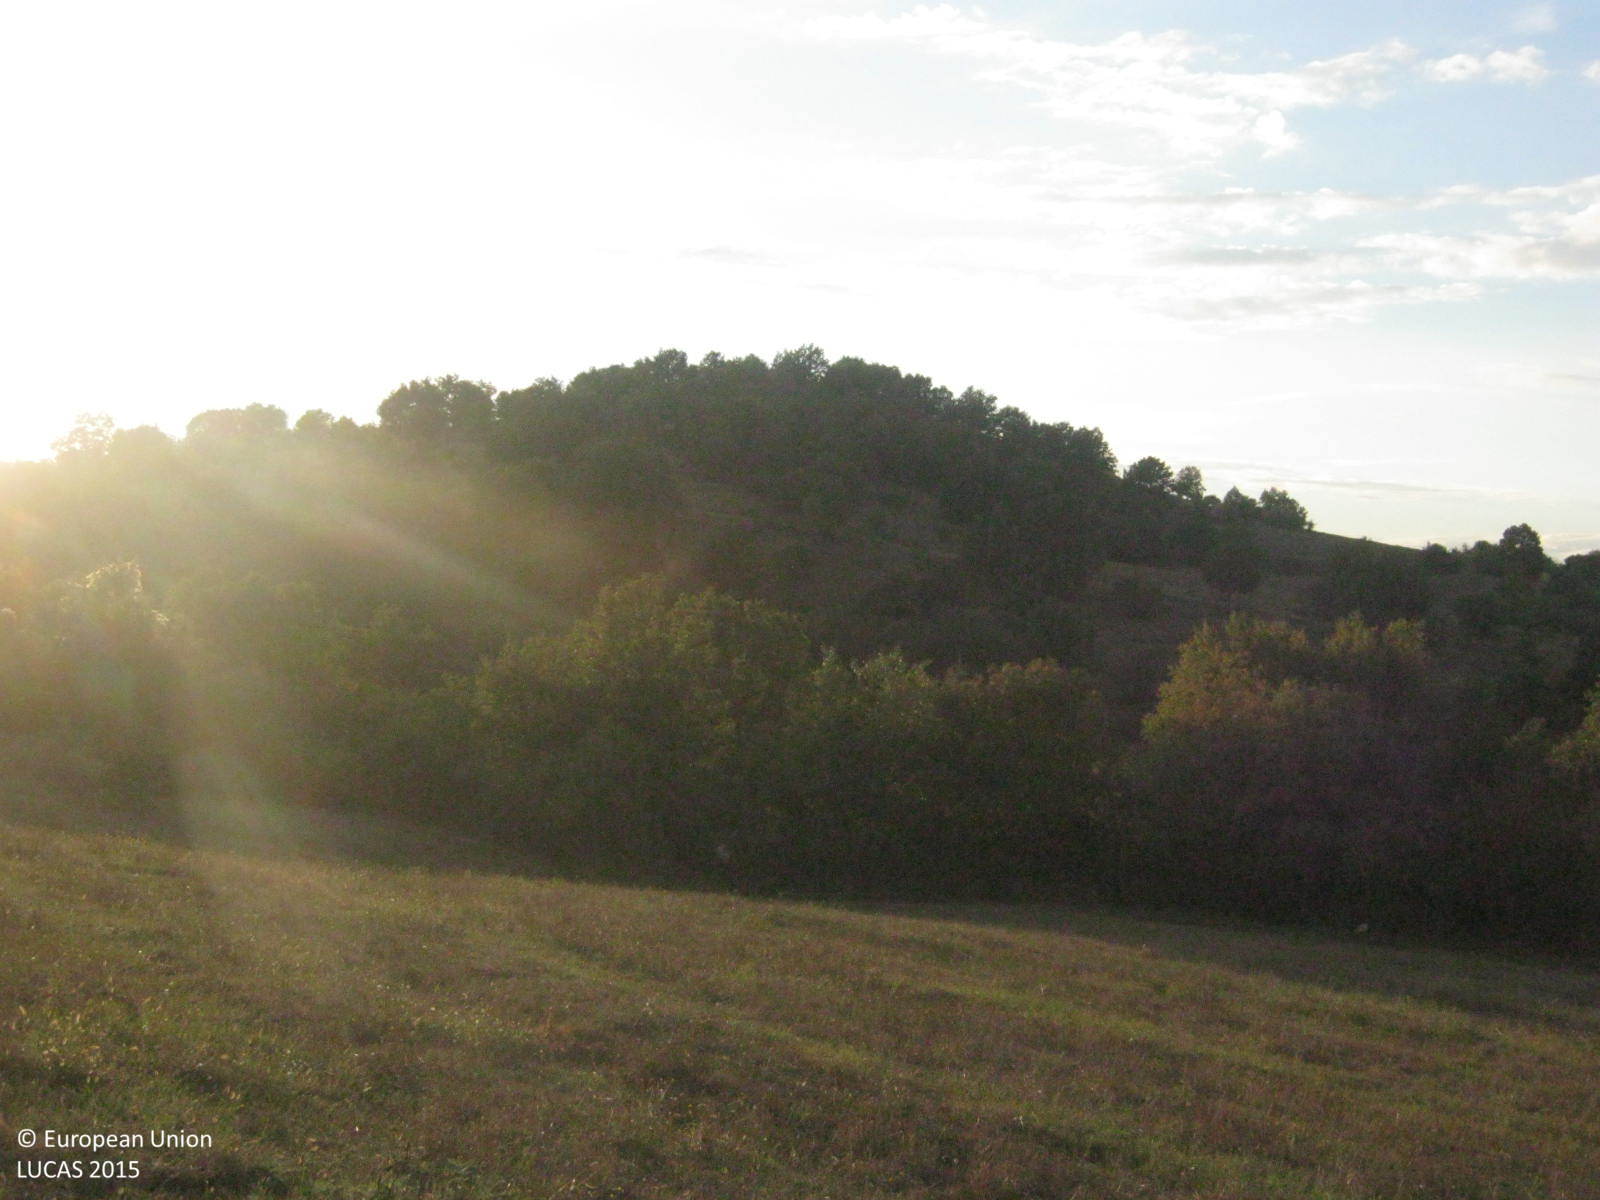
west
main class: Cropland
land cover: Common wheat
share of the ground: > 75 %
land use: Agriculture (excluding fallow land and kitchen gardens)
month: September
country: GR
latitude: 41.0458
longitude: 22.9917
